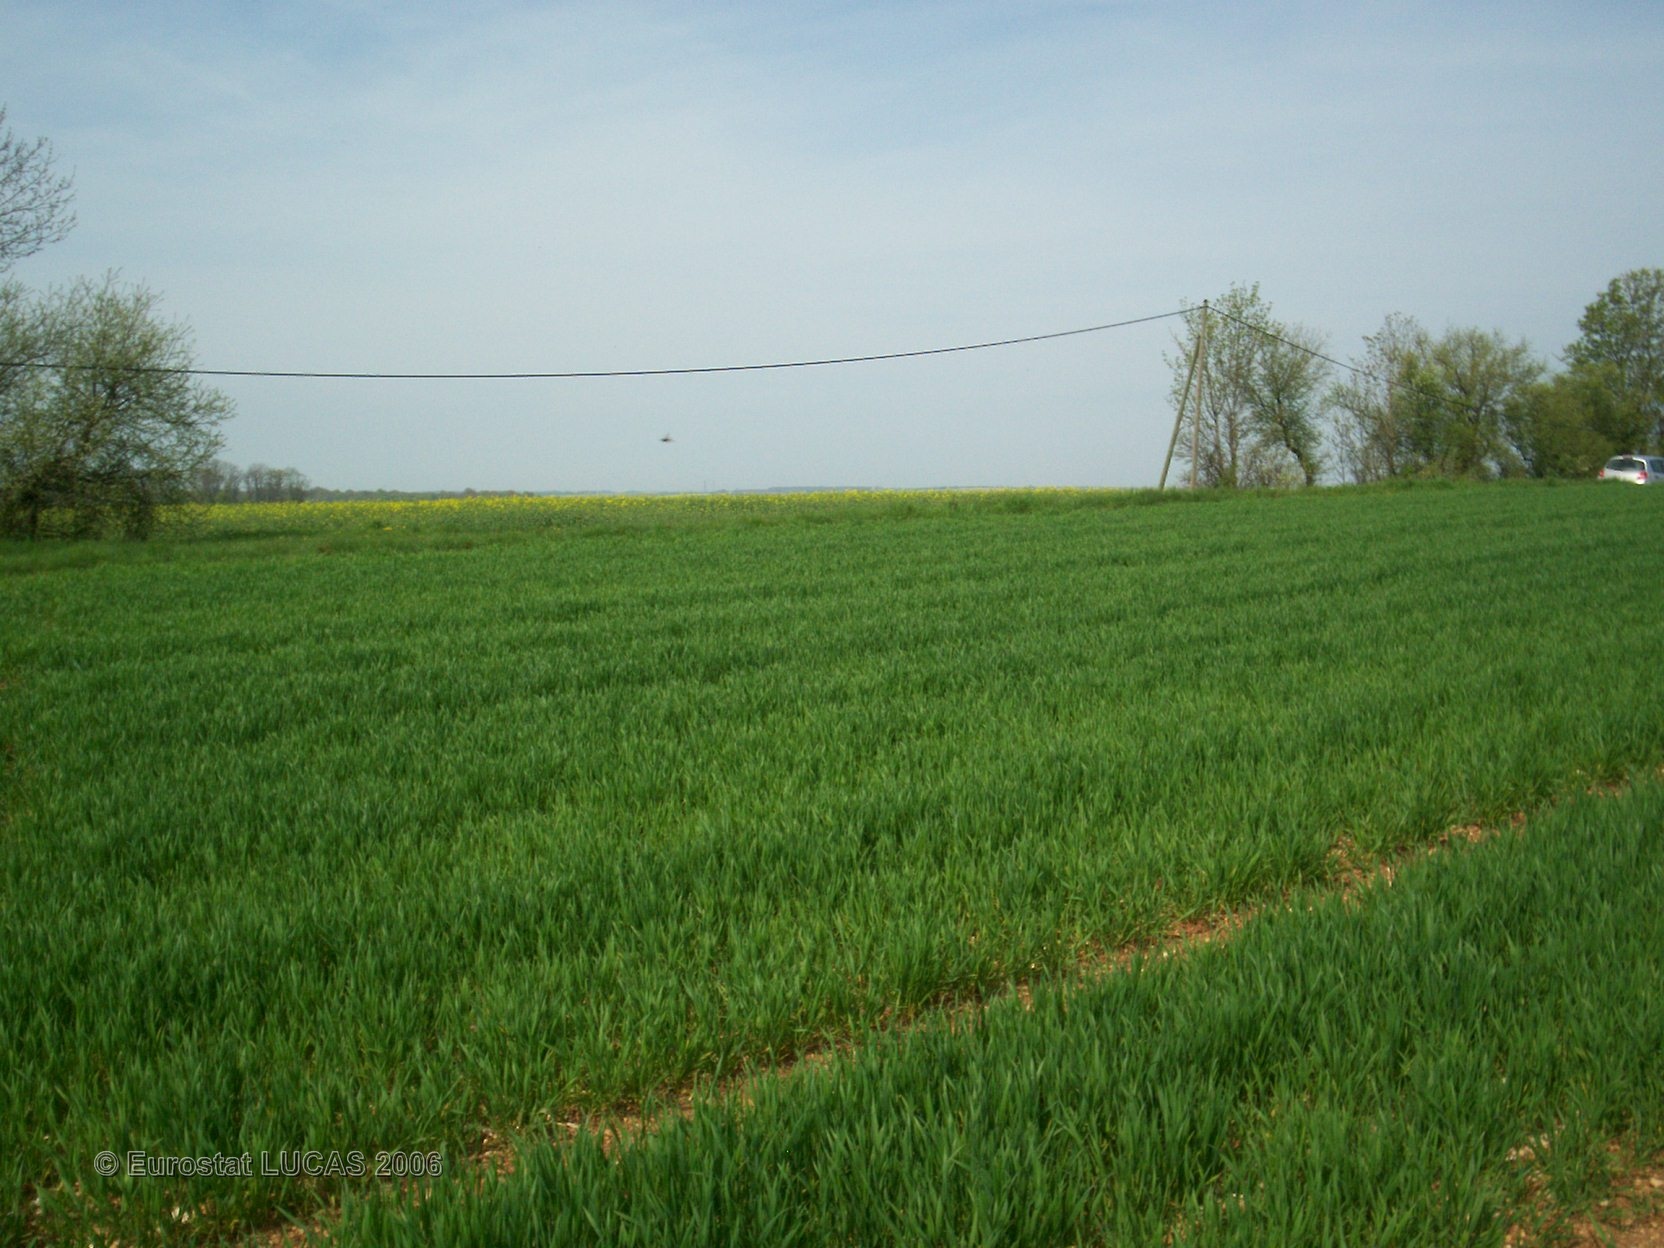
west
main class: Cropland
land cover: Common wheat
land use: Agriculture (excluding fallow land and kitchen gardens)
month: May
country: FR
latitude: 47.6061
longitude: 4.6385
